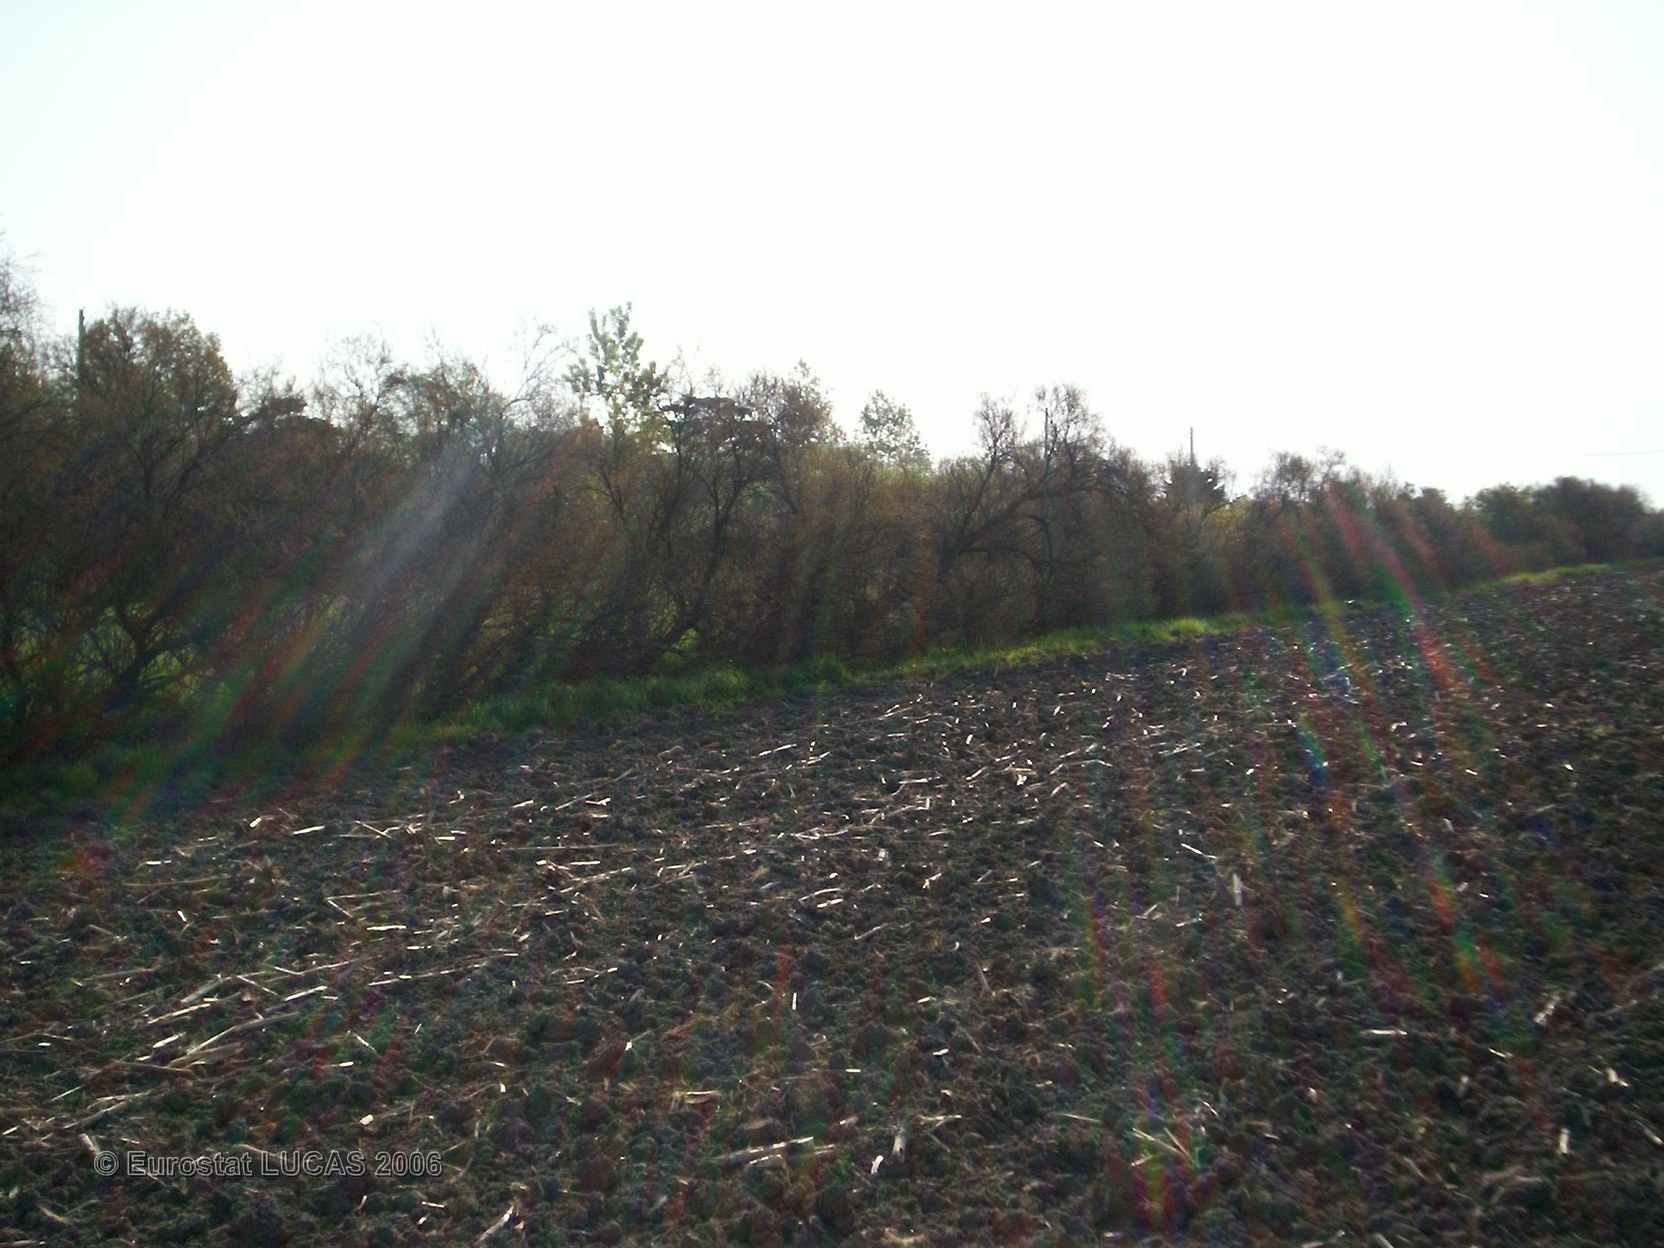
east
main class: Cropland
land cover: Other cereals
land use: Agriculture (excluding fallow land and kitchen gardens)
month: May
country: FR
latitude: 46.8122
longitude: -2.0645
